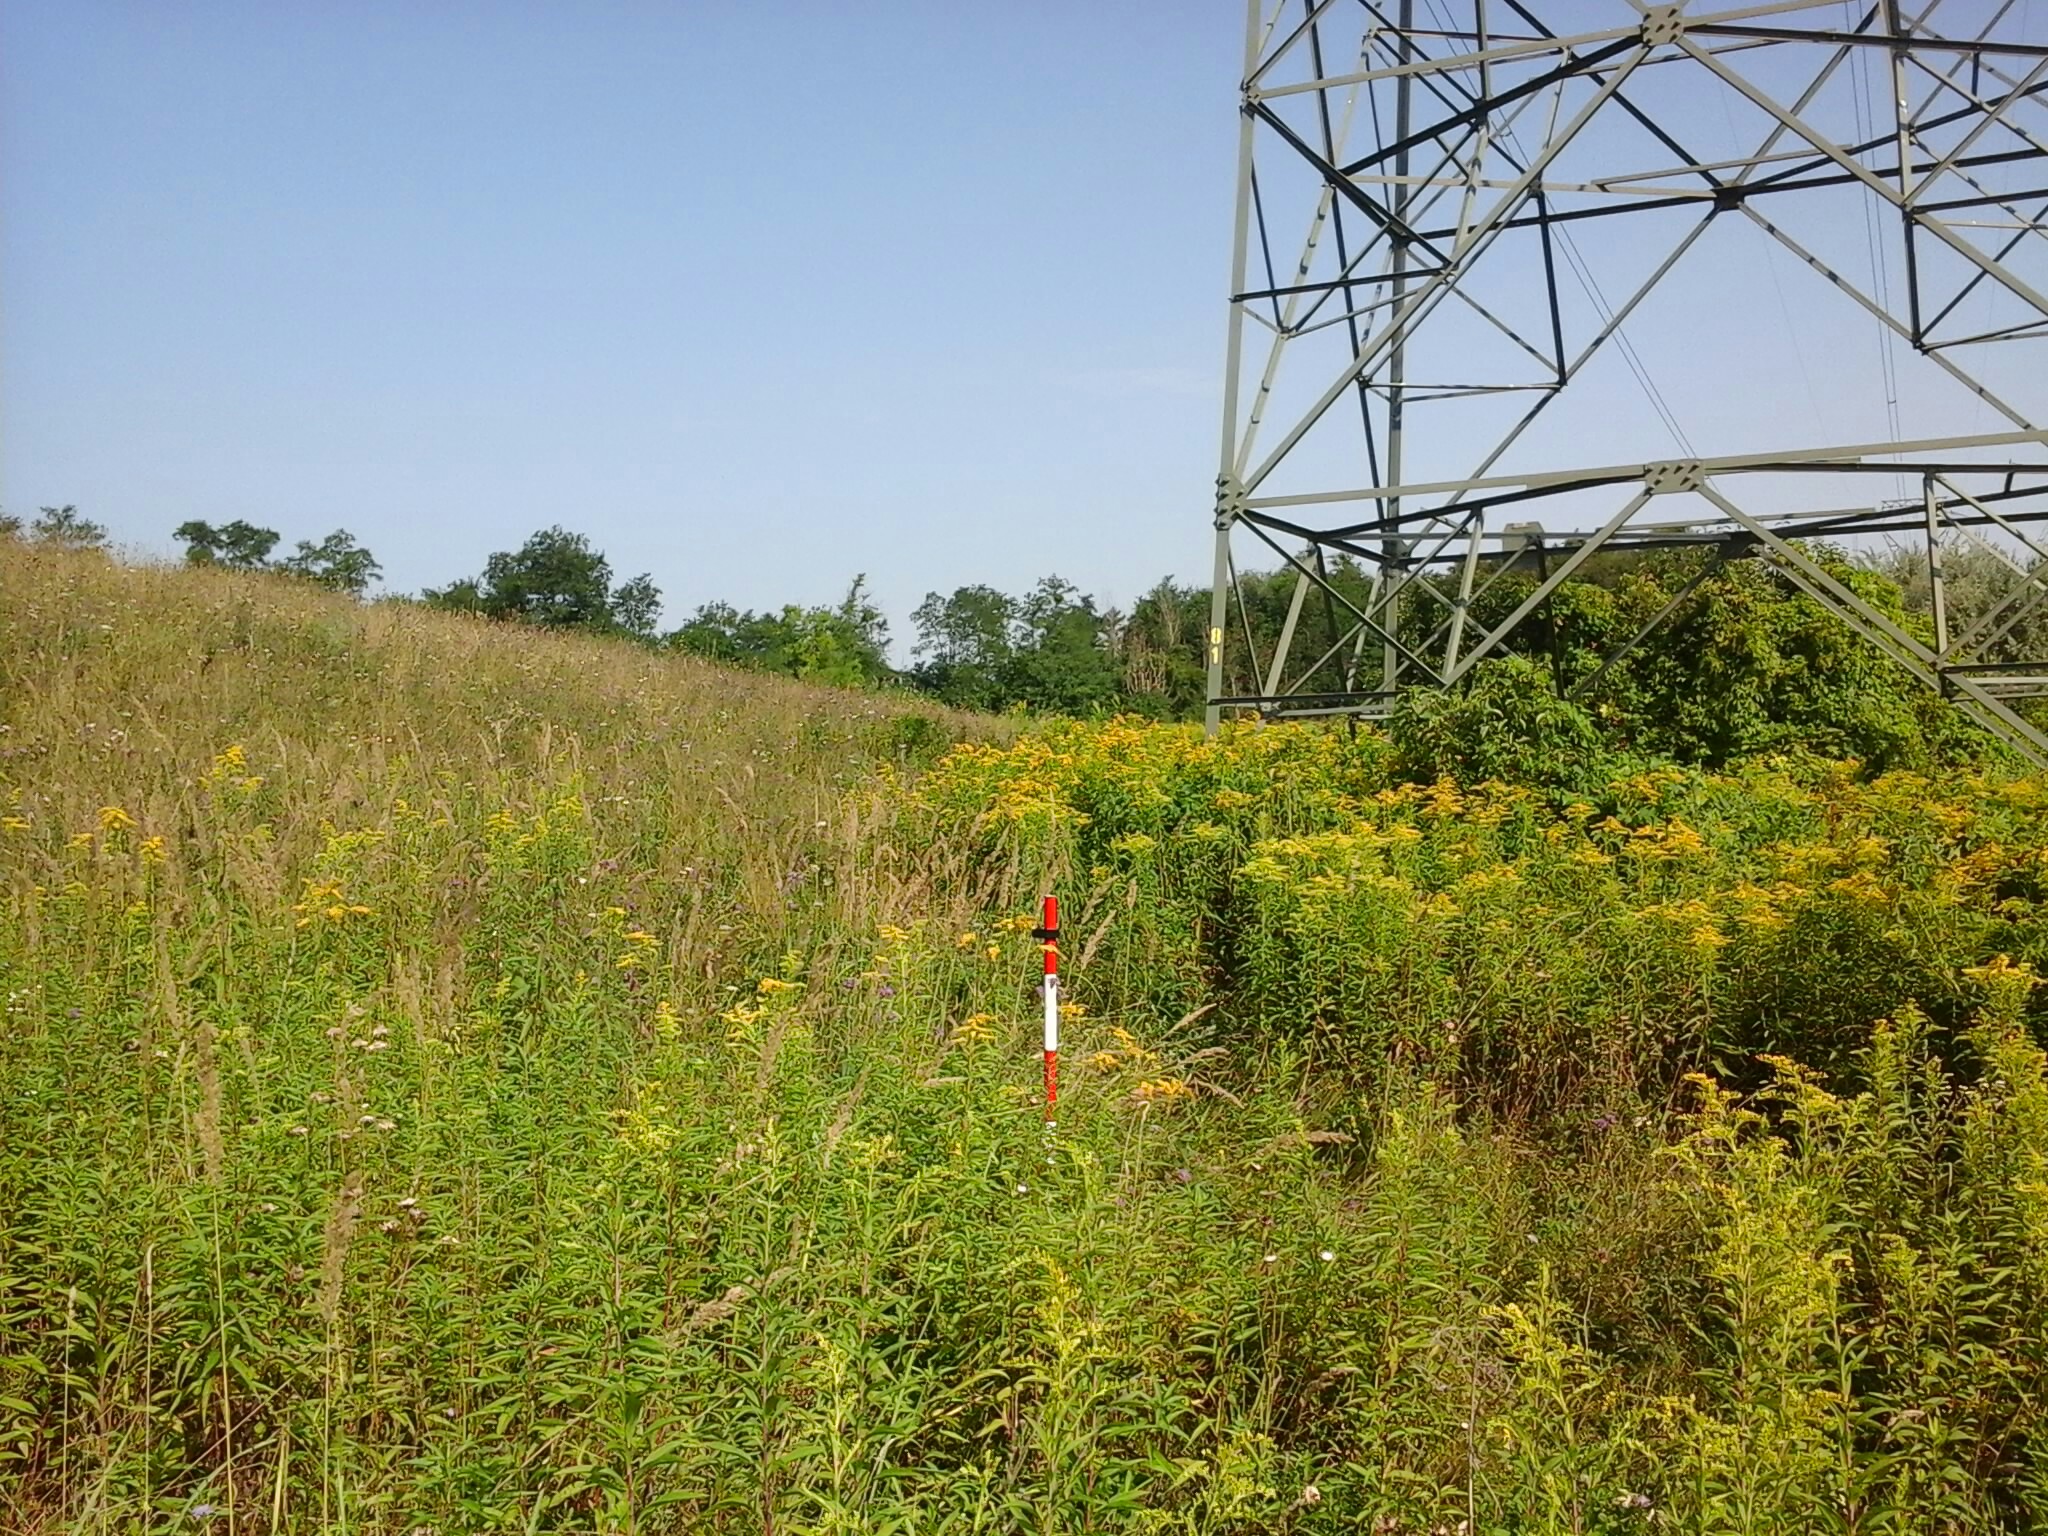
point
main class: Grassland
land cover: Grassland without tree/shrub cover
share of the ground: > 75 %
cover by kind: herbaceous plants 95 %, shrubs 5 %
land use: Agriculture (excluding fallow land and kitchen gardens)
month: August
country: HU
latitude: 47.4515
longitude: 17.9015
